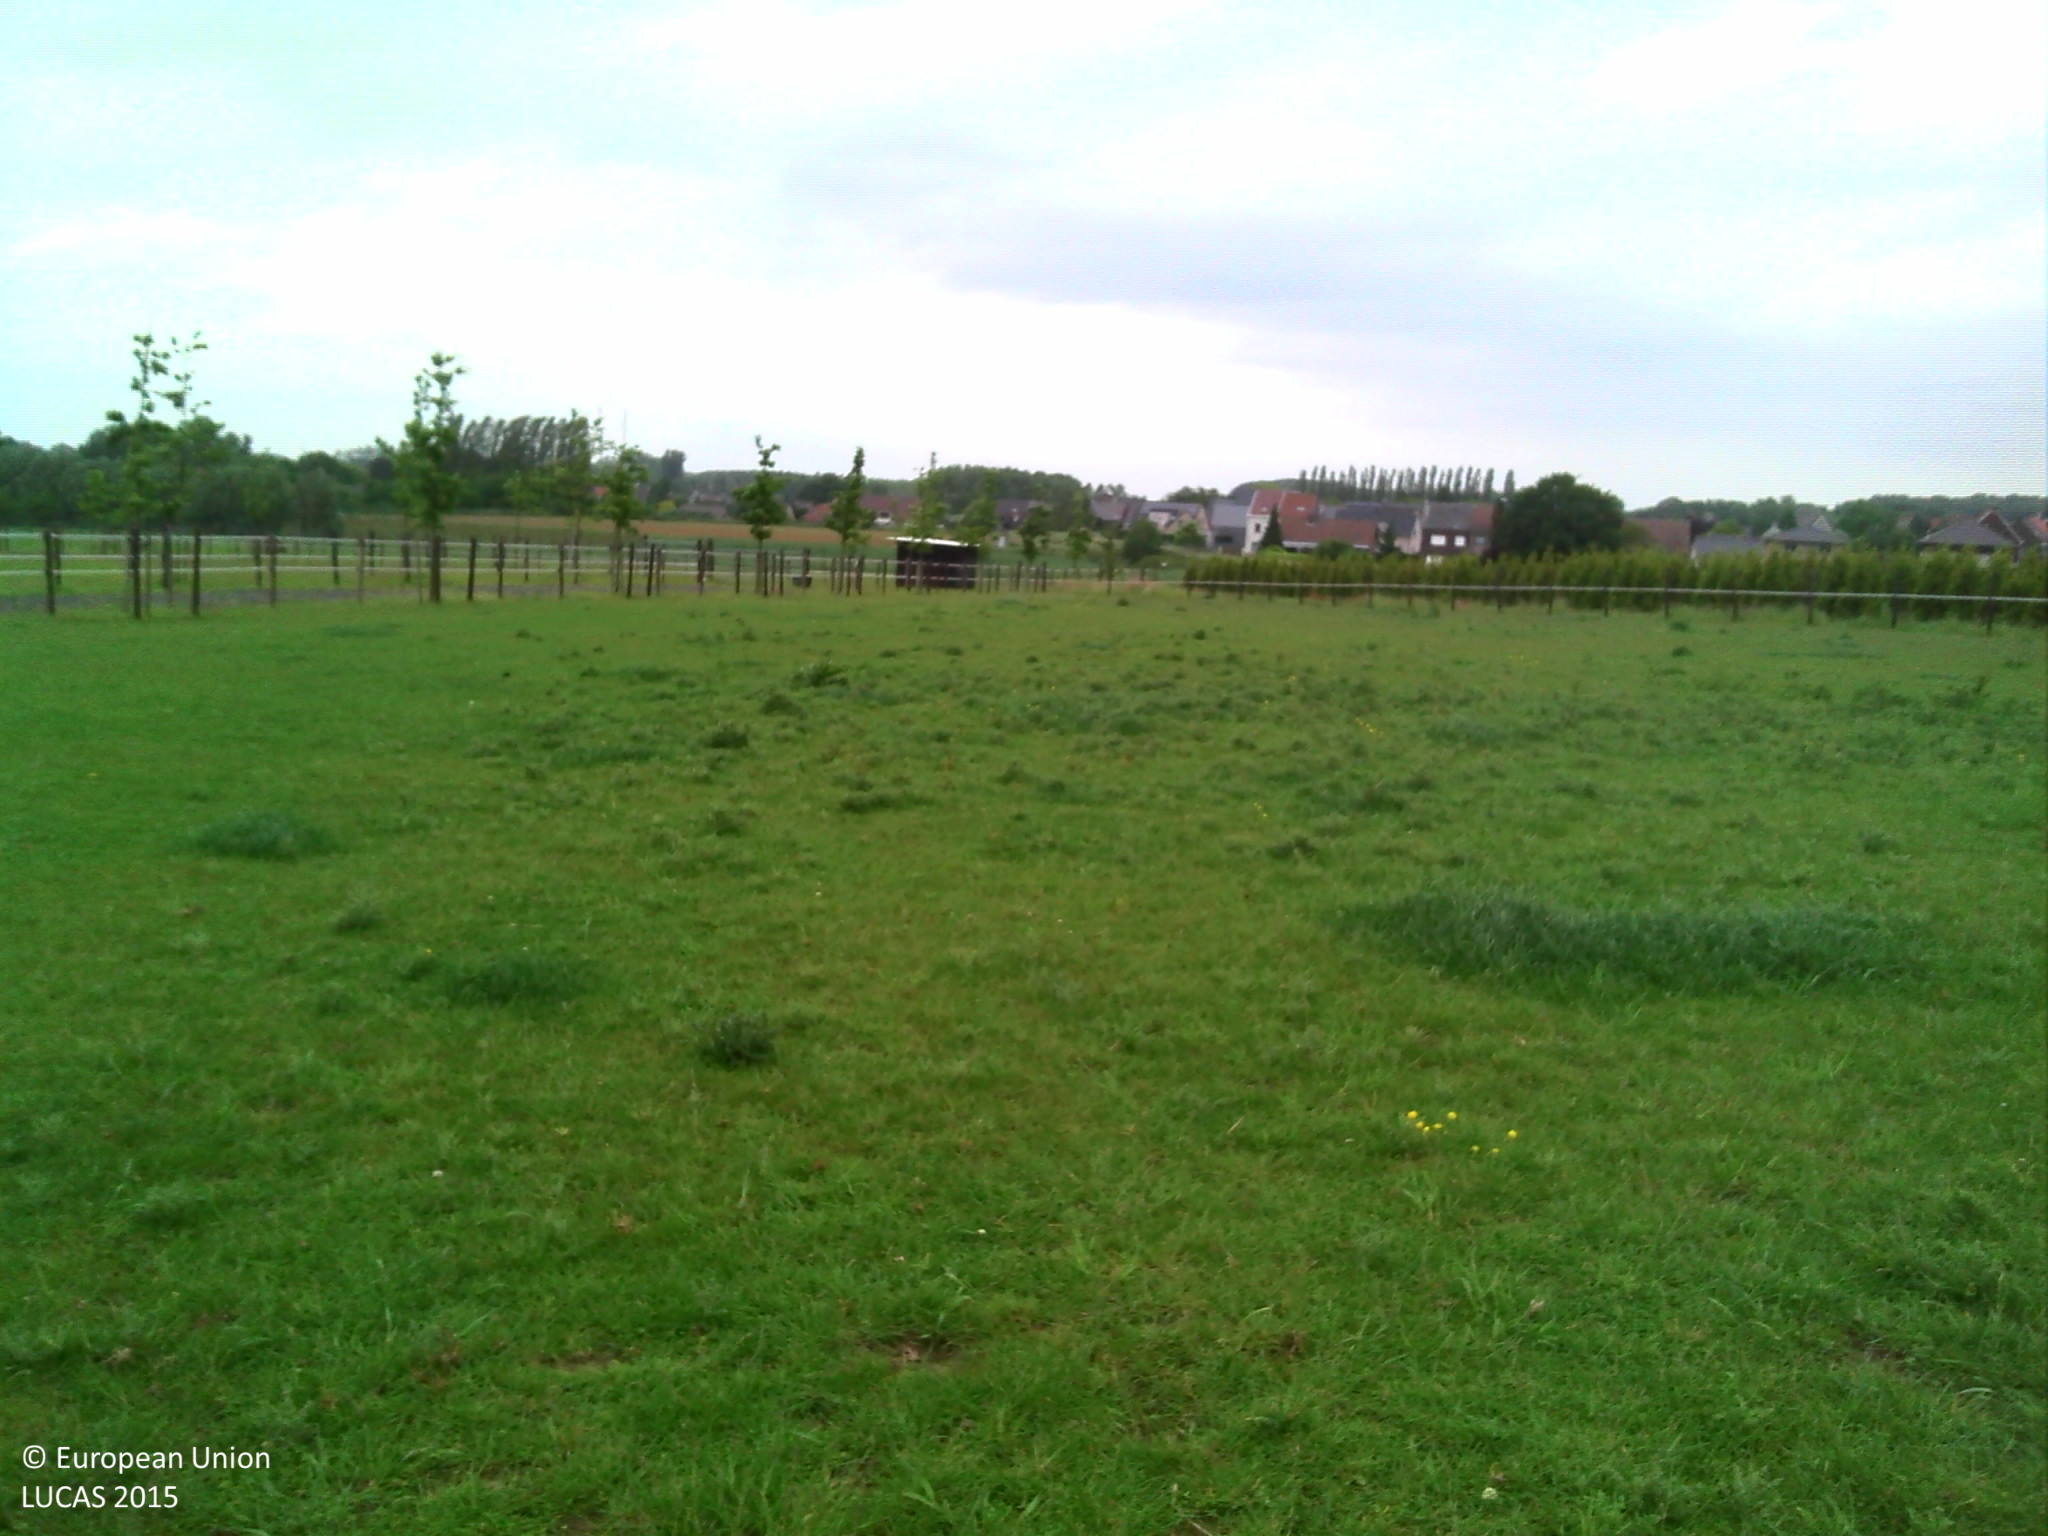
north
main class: Grassland
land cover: Grassland without tree/shrub cover
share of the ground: > 75 %
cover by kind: herbaceous plants 100 %
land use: Agriculture (excluding fallow land and kitchen gardens)
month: June
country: BE
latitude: 50.8817
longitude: 3.8106
